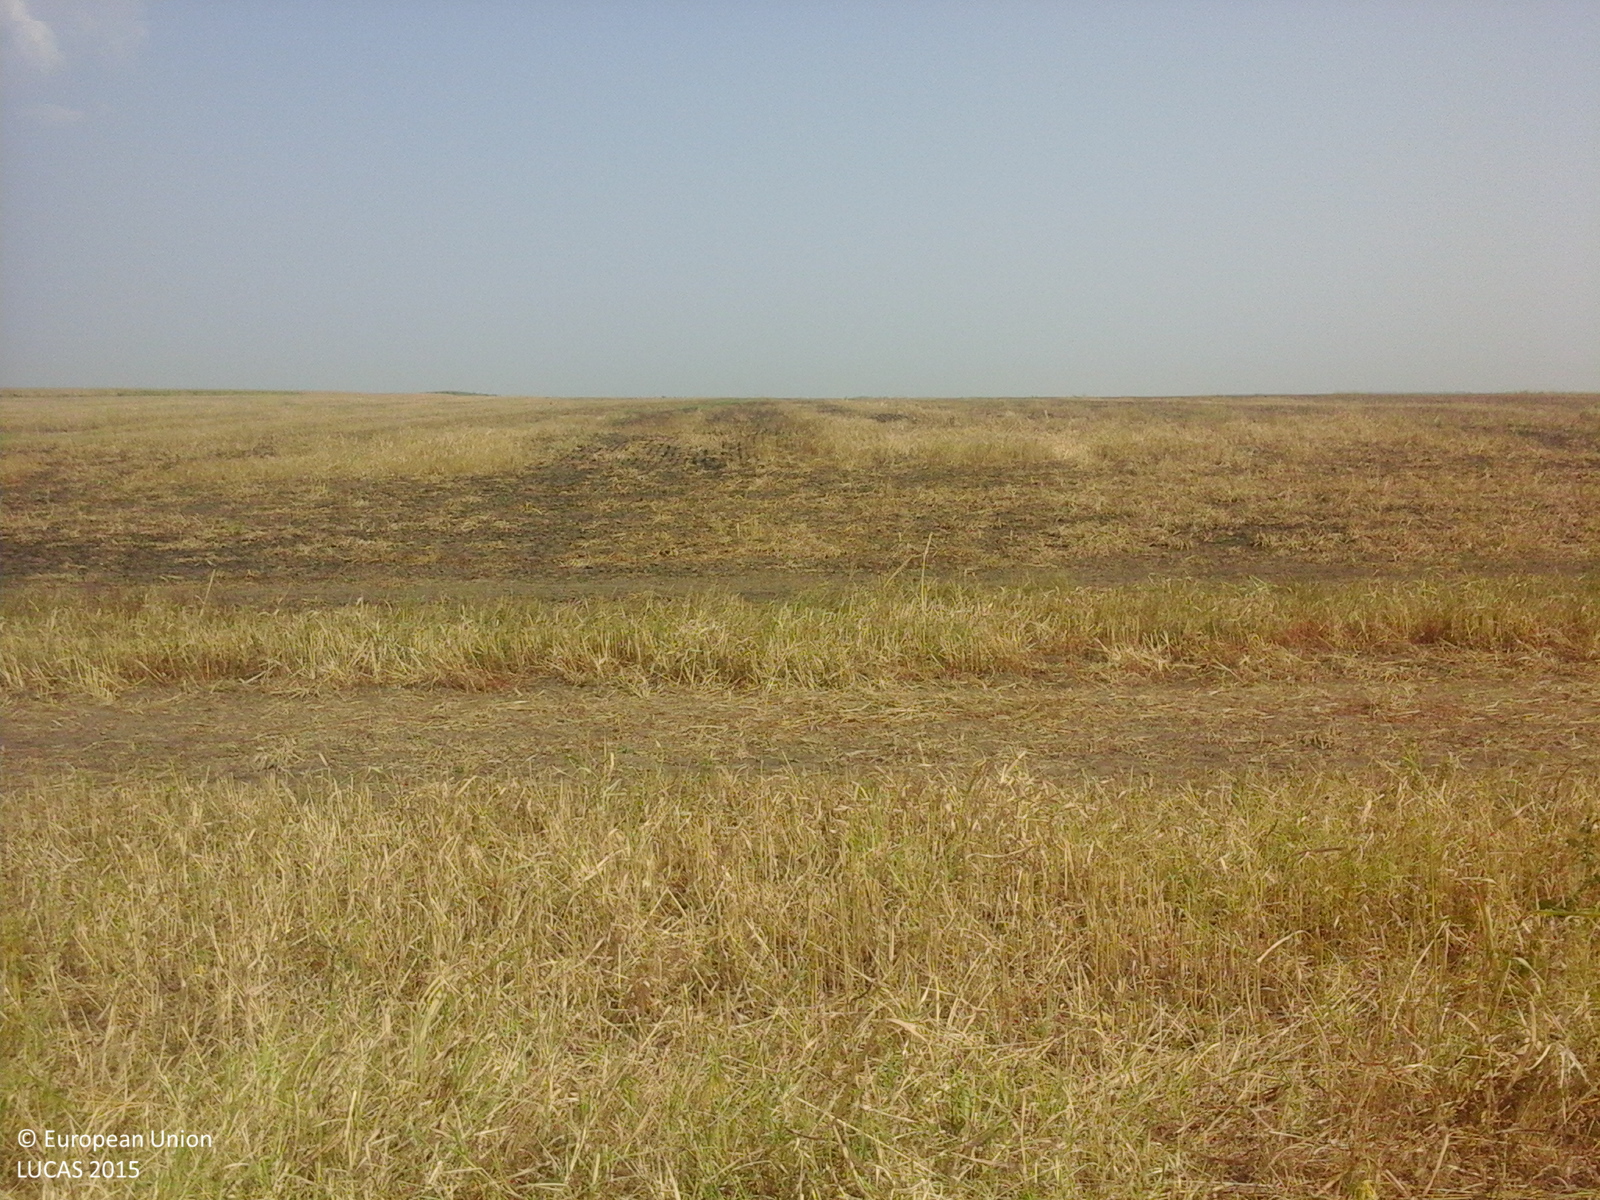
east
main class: Cropland
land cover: Maize
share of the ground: > 75 %
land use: Agriculture (excluding fallow land and kitchen gardens)
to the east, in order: Maize; Grass margins; Ditches and canals; Grass margins; Common wheat
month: August
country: RO
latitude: 43.9496
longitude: 23.4173
